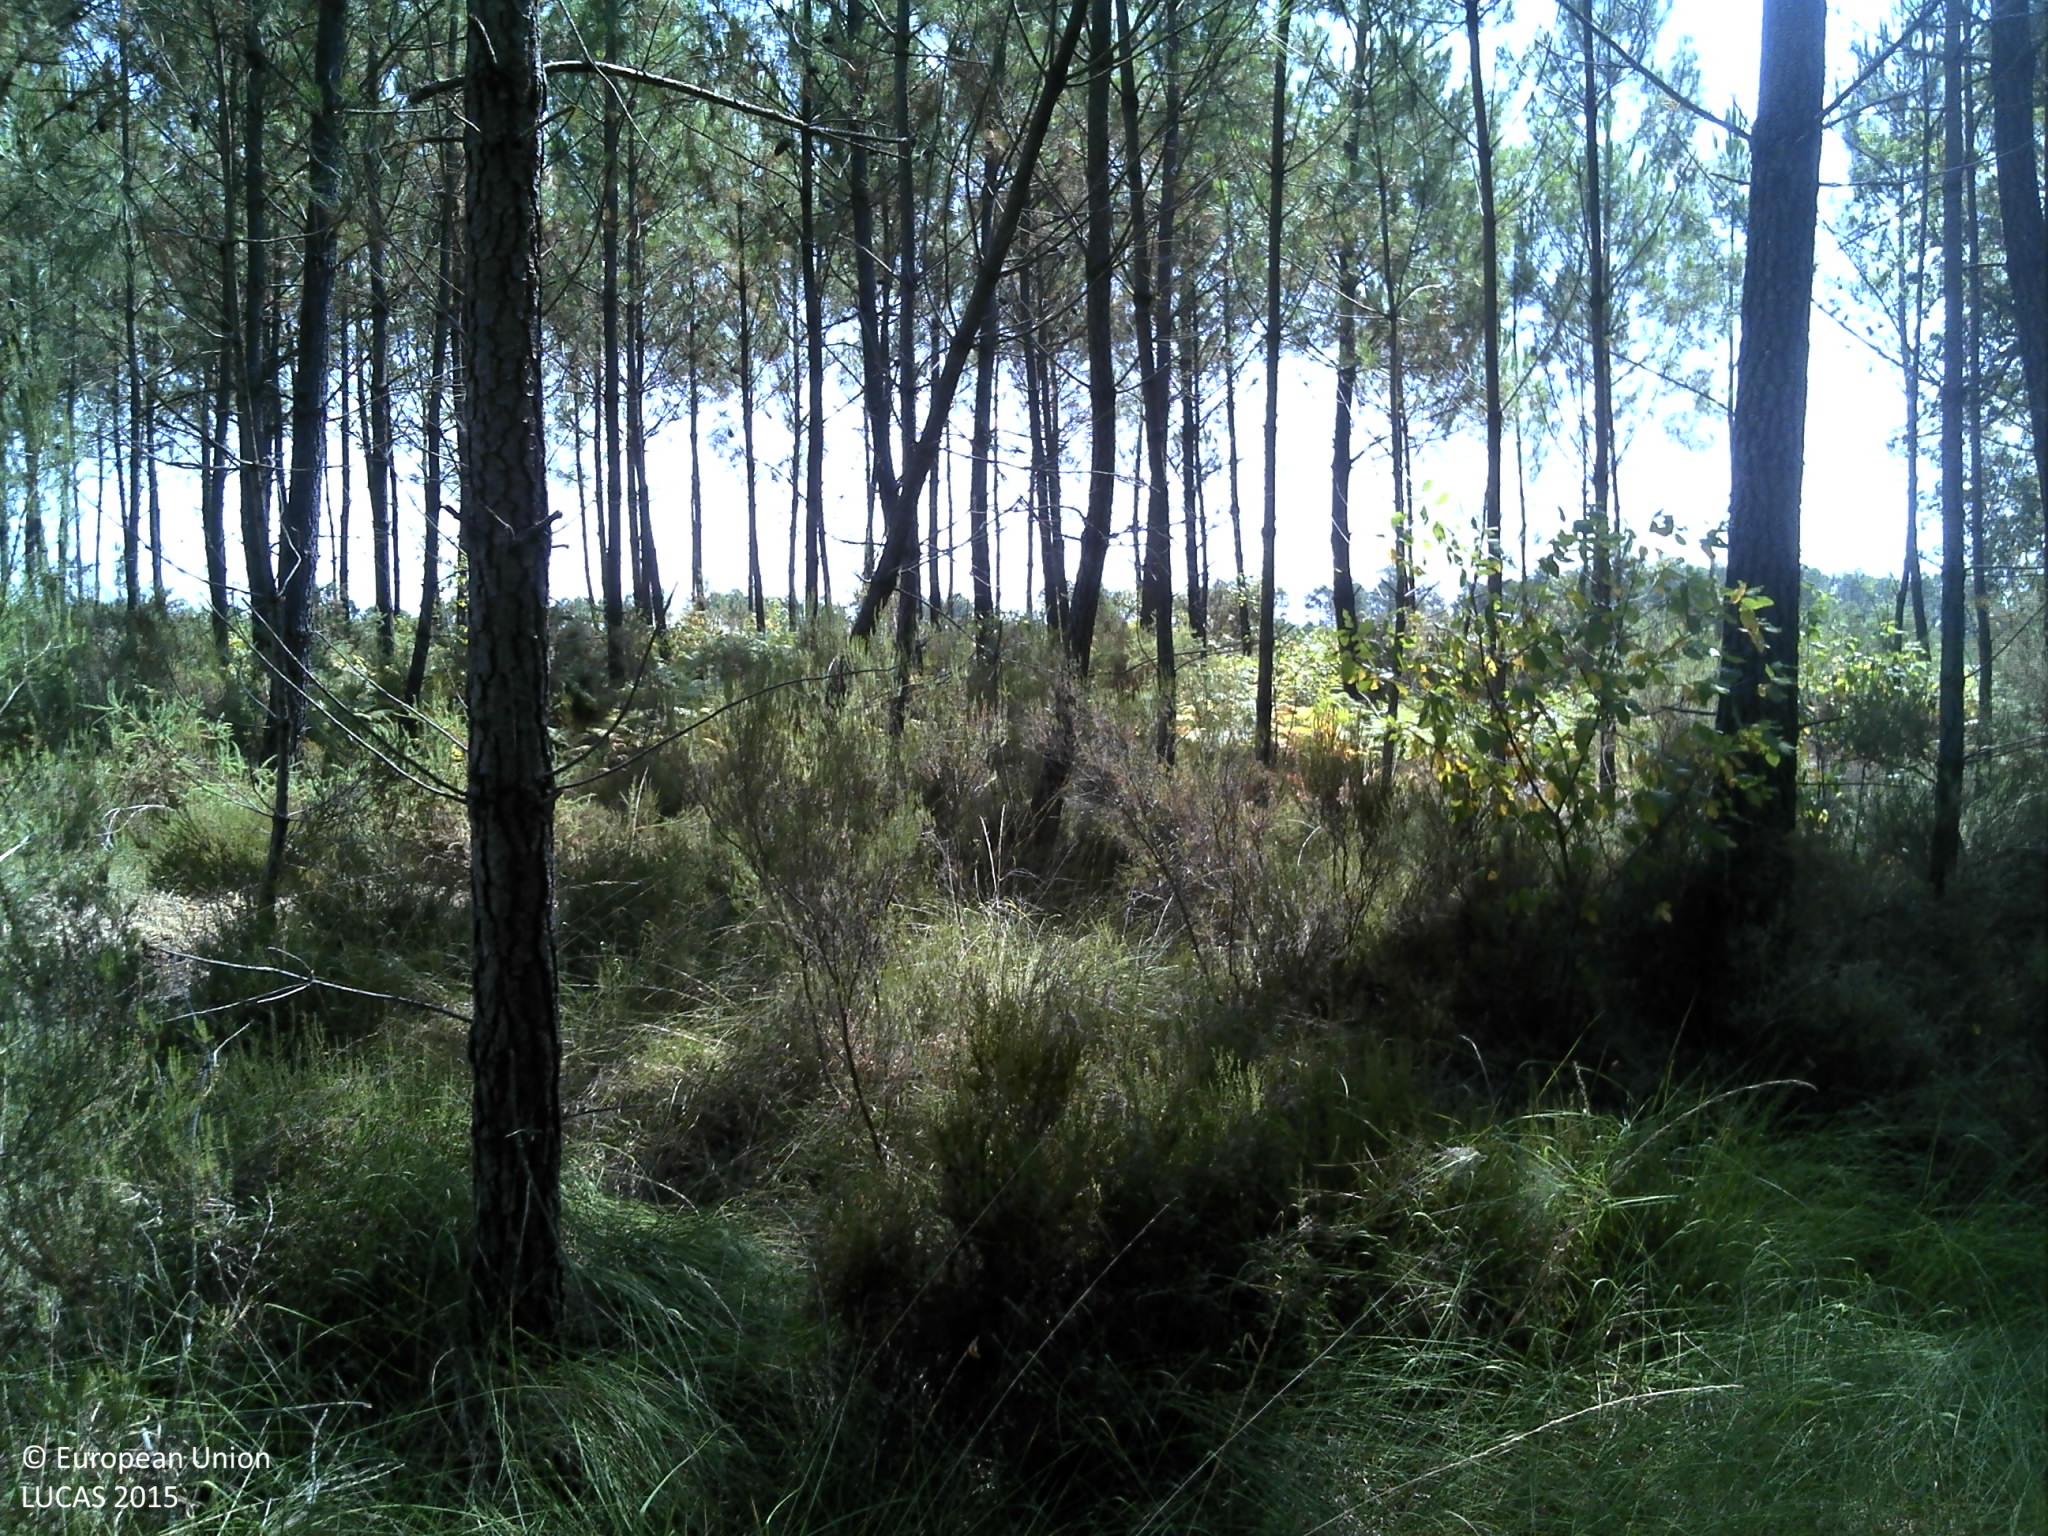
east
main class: Woodland
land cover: Pine dominated coniferous woodland
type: coniferous forest of the mediterranean region
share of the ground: > 75 %
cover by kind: coniferous forest trees 70 %, shrubs 20 %, herbaceous plants 10 %
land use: Forestry
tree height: > 5 m
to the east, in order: Pine dominated coniferous woodland; Tracks; Pine dominated coniferous woodland; Shrubland with sparse tree cover
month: July
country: FR
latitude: 44.5942
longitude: -0.7134
